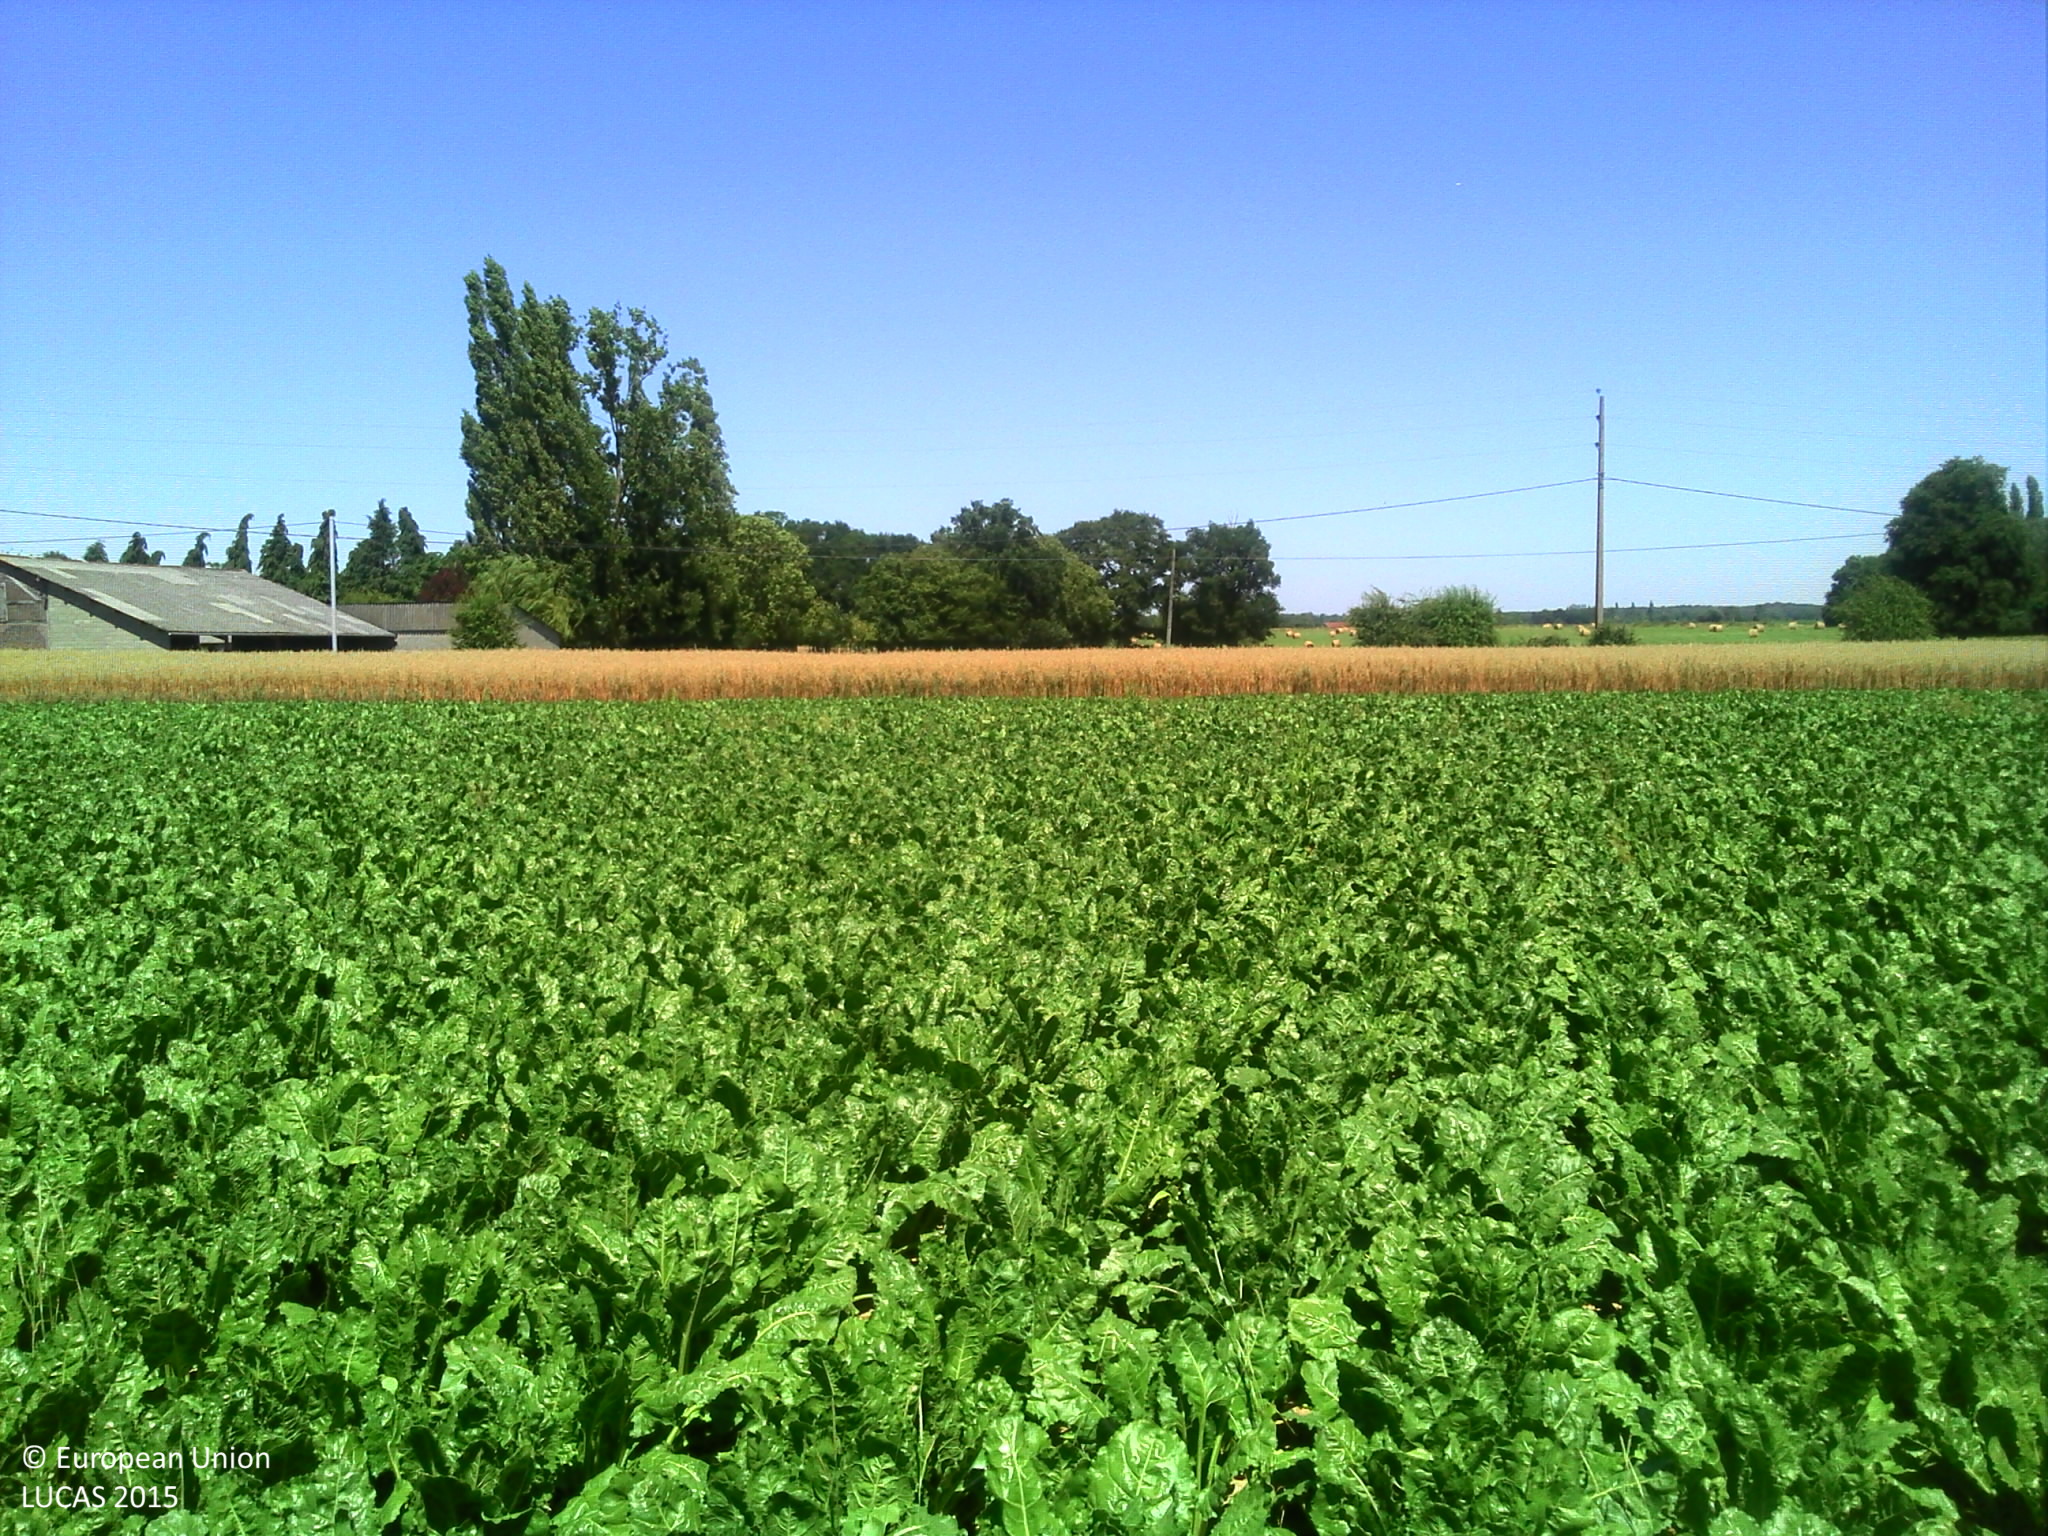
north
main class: Cropland
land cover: Sugar beet
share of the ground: > 75 %
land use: Agriculture (excluding fallow land and kitchen gardens)
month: July
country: FR
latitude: 49.0568
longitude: 0.4353
